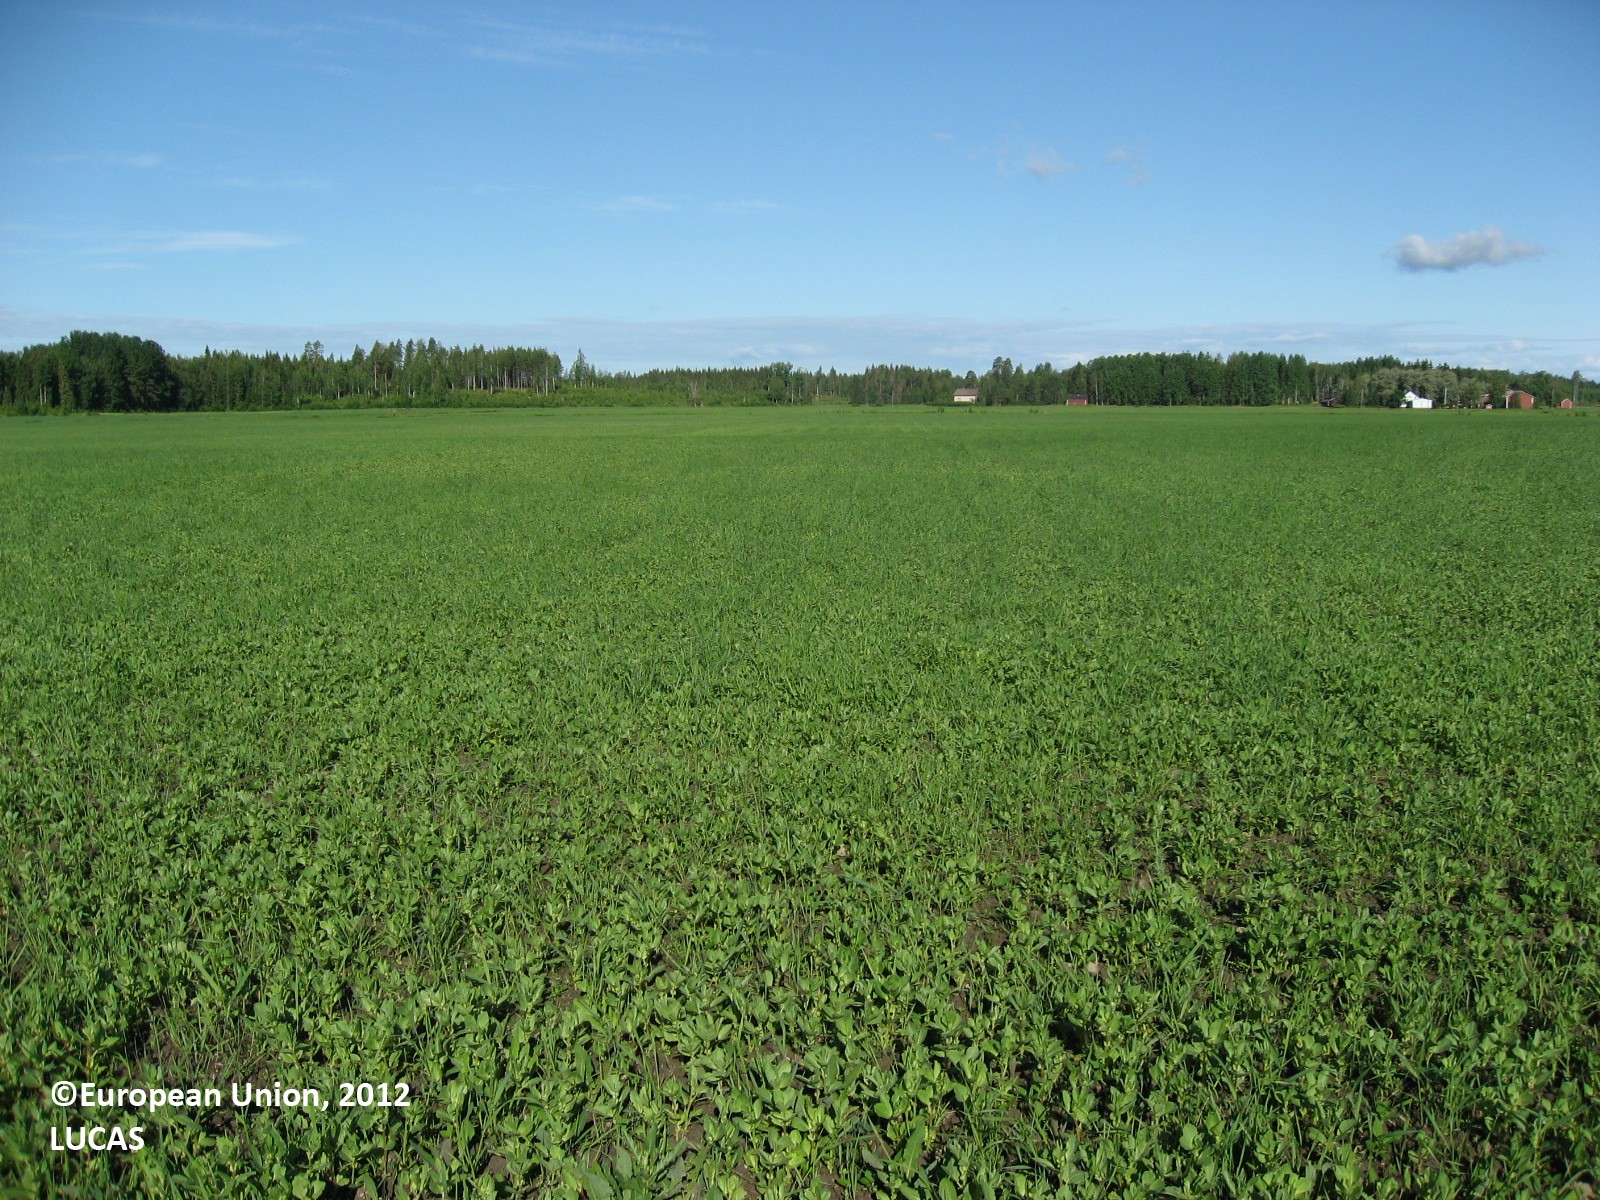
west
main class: Cropland
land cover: Dry pulses
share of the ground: 50 - 75 %
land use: Agriculture (excluding fallow land and kitchen gardens)
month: June
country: FI
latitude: 60.6528
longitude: 26.3759
